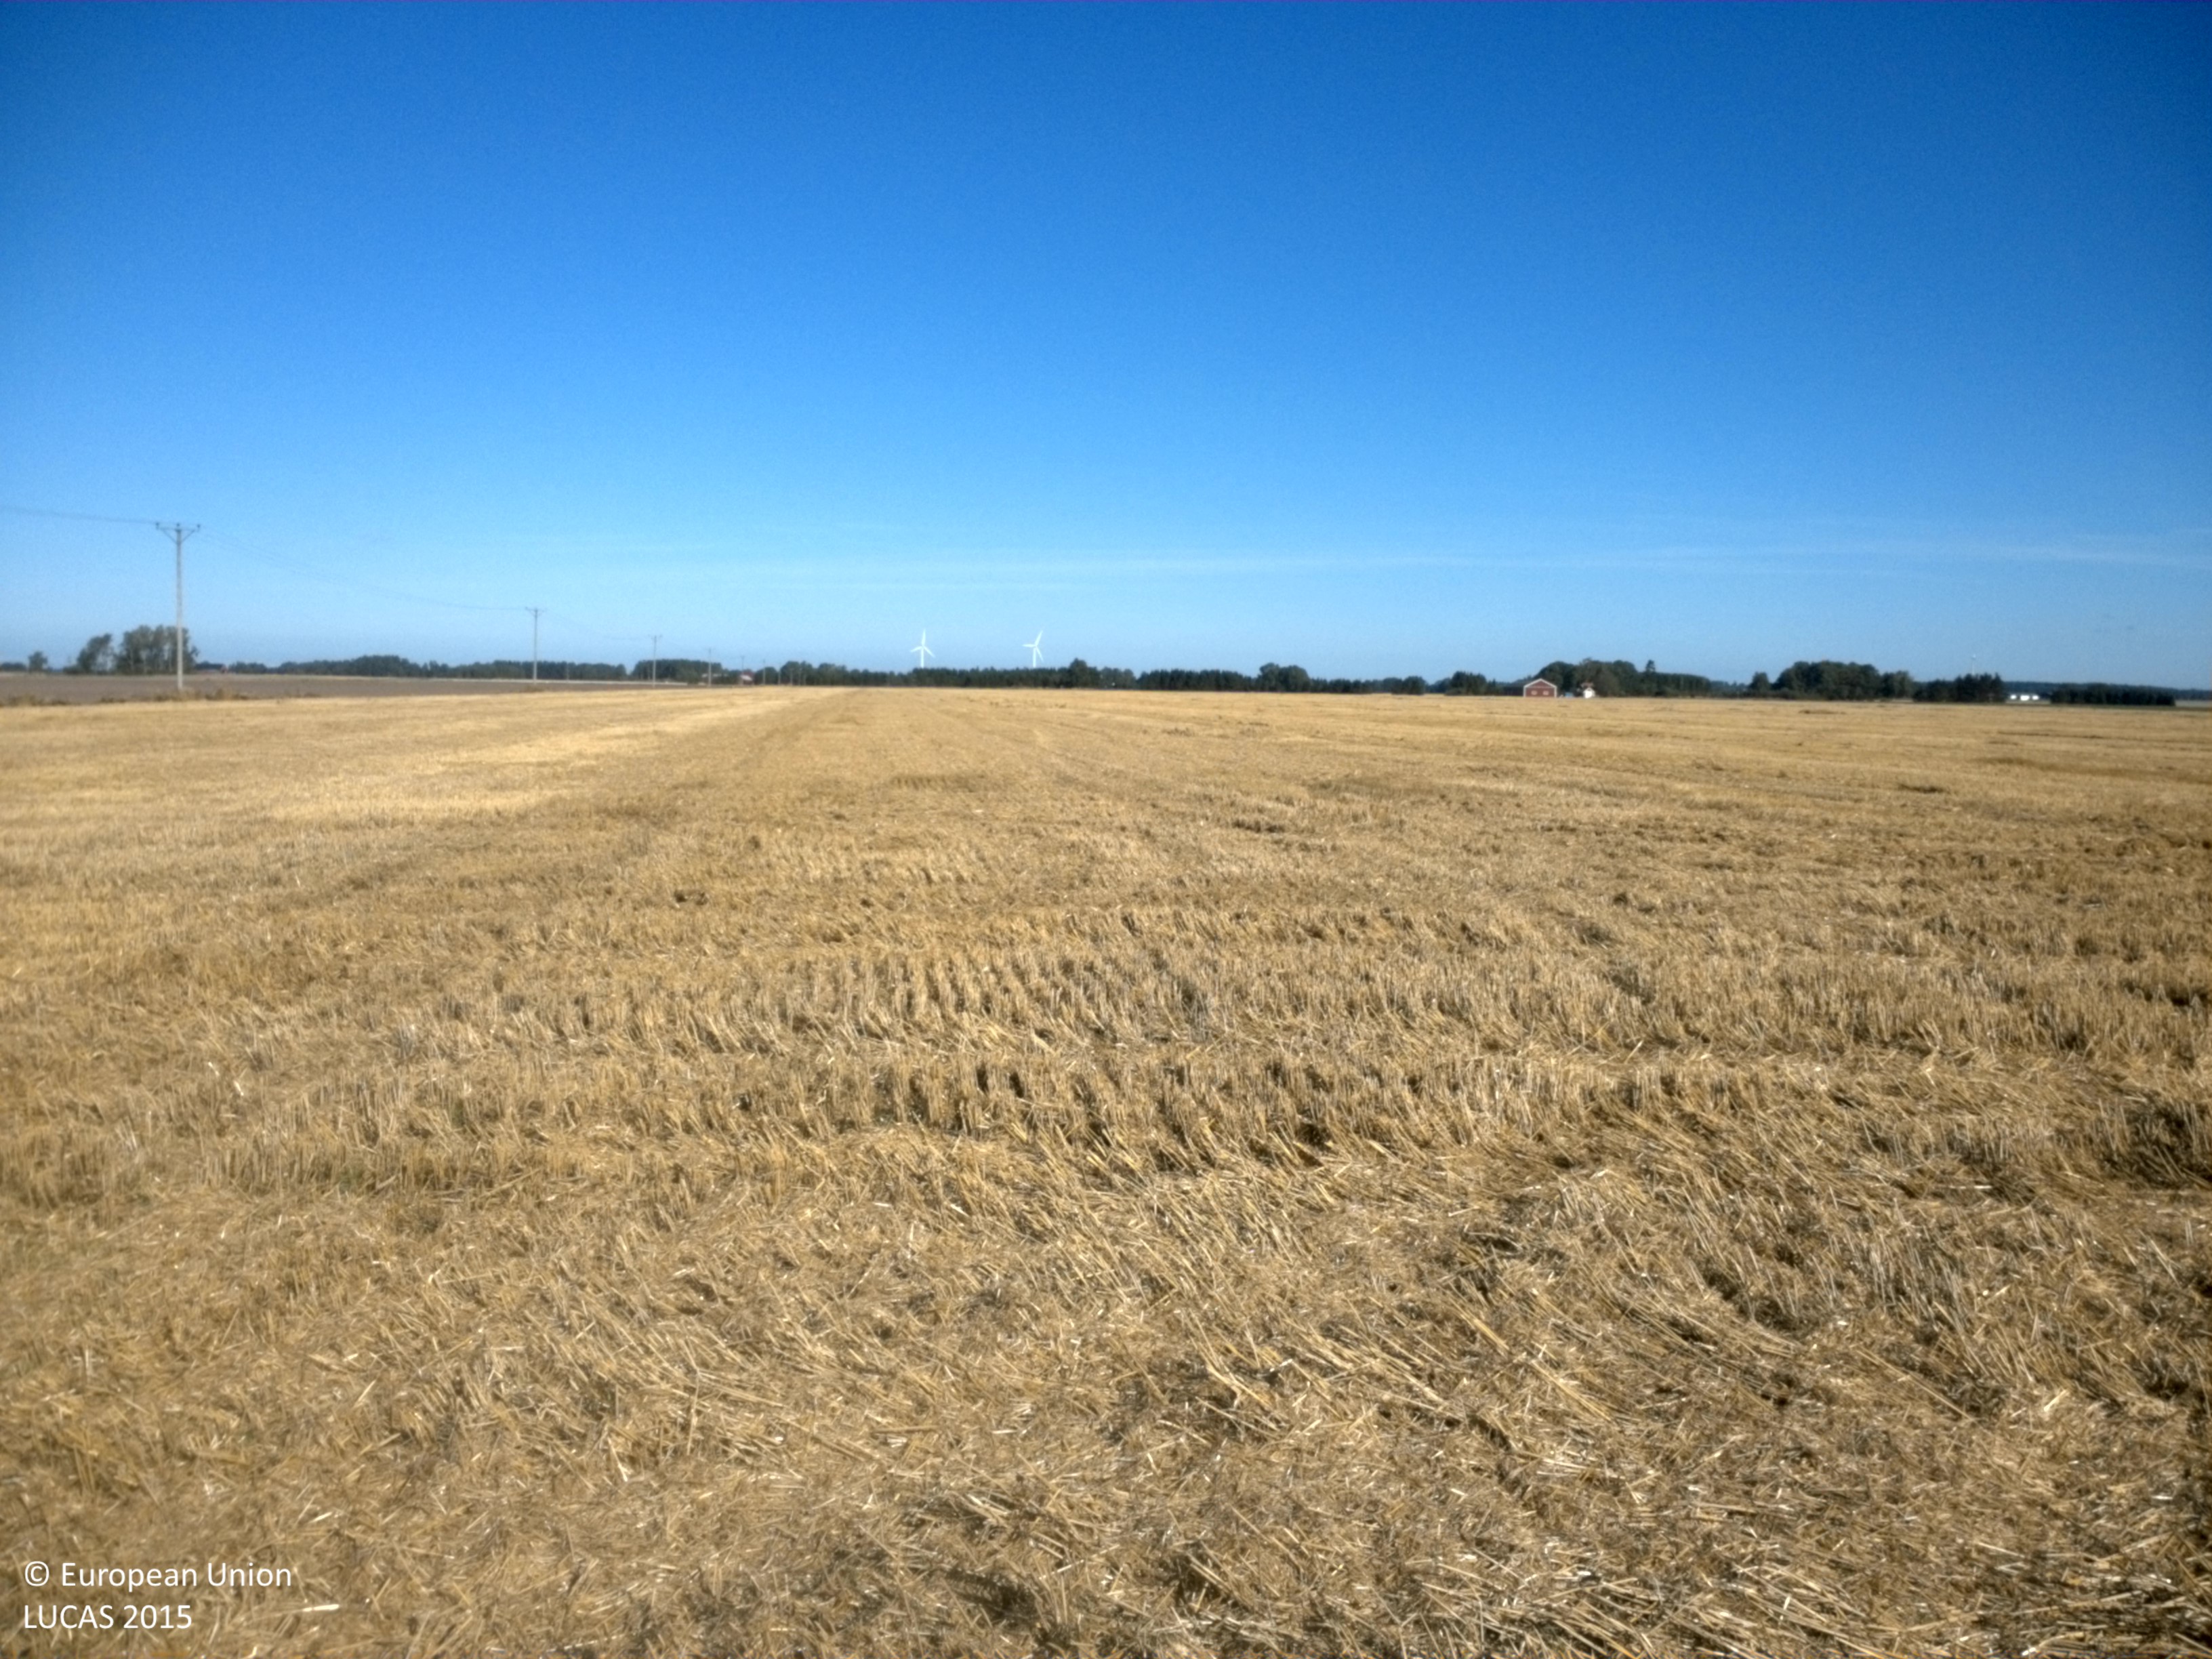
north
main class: Cropland
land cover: Common wheat
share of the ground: 50 - 75 %
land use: Agriculture (excluding fallow land and kitchen gardens)
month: September
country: SE
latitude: 58.3968
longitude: 13.2279
